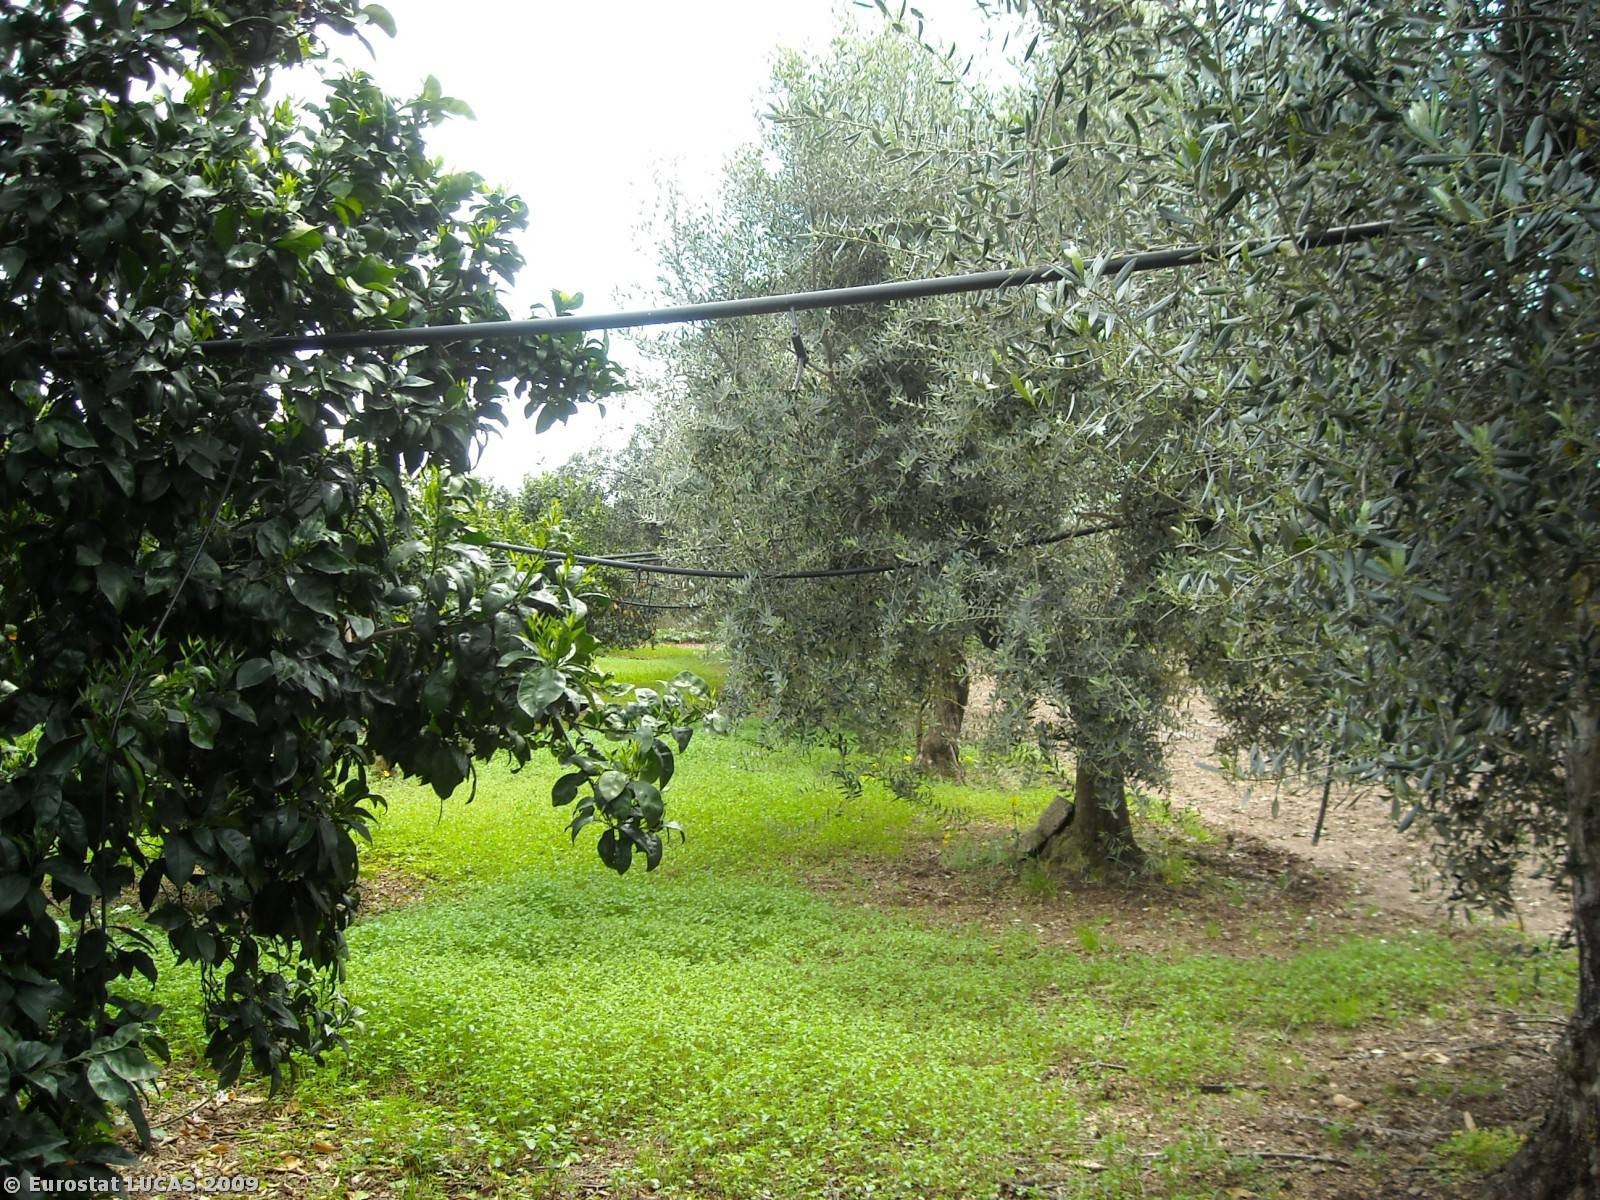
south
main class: Cropland
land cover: Oranges
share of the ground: 25 - 50 %
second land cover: Spontaneously vegetated surfaces
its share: > 75 %
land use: Agriculture (excluding fallow land and kitchen gardens)
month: April
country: IT
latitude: 40.5091
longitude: 16.9740
